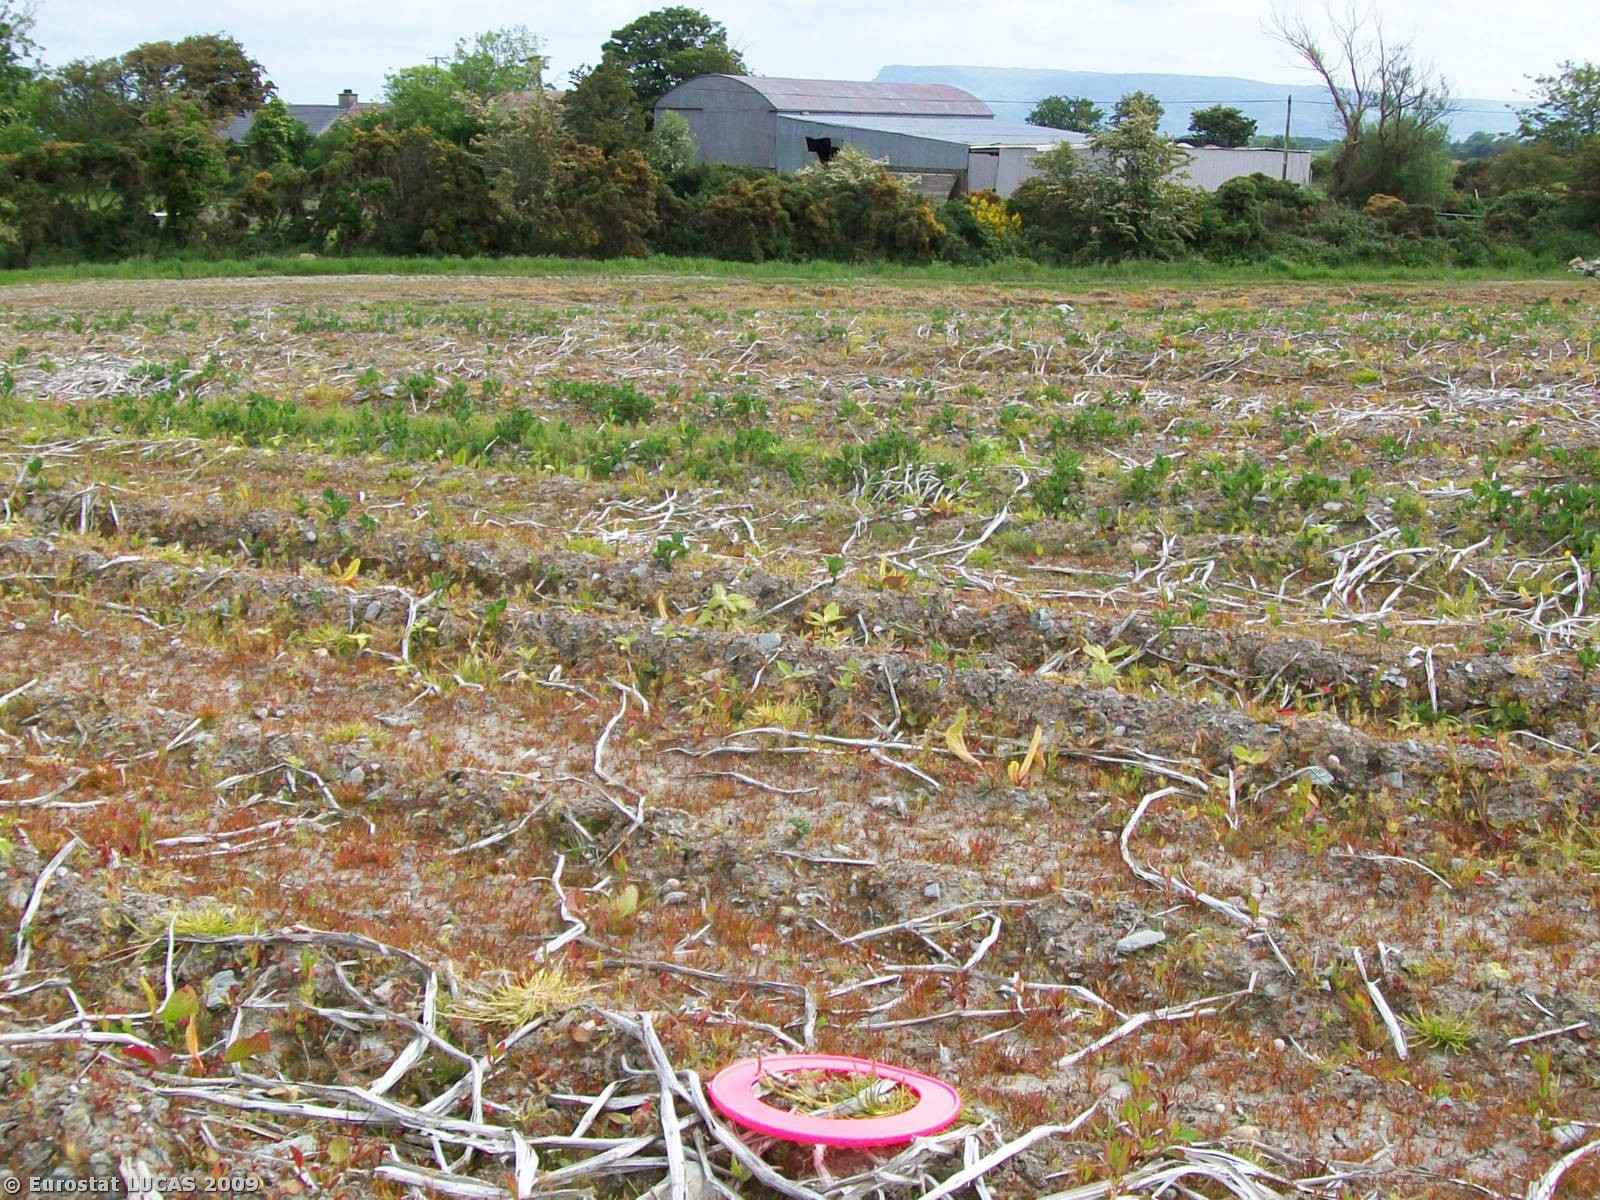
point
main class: Cropland
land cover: Potatoes
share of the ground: > 75 %
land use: Agriculture (excluding fallow land and kitchen gardens)
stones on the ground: < 10 %
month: June
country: GB
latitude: 55.0289
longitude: -7.0831
